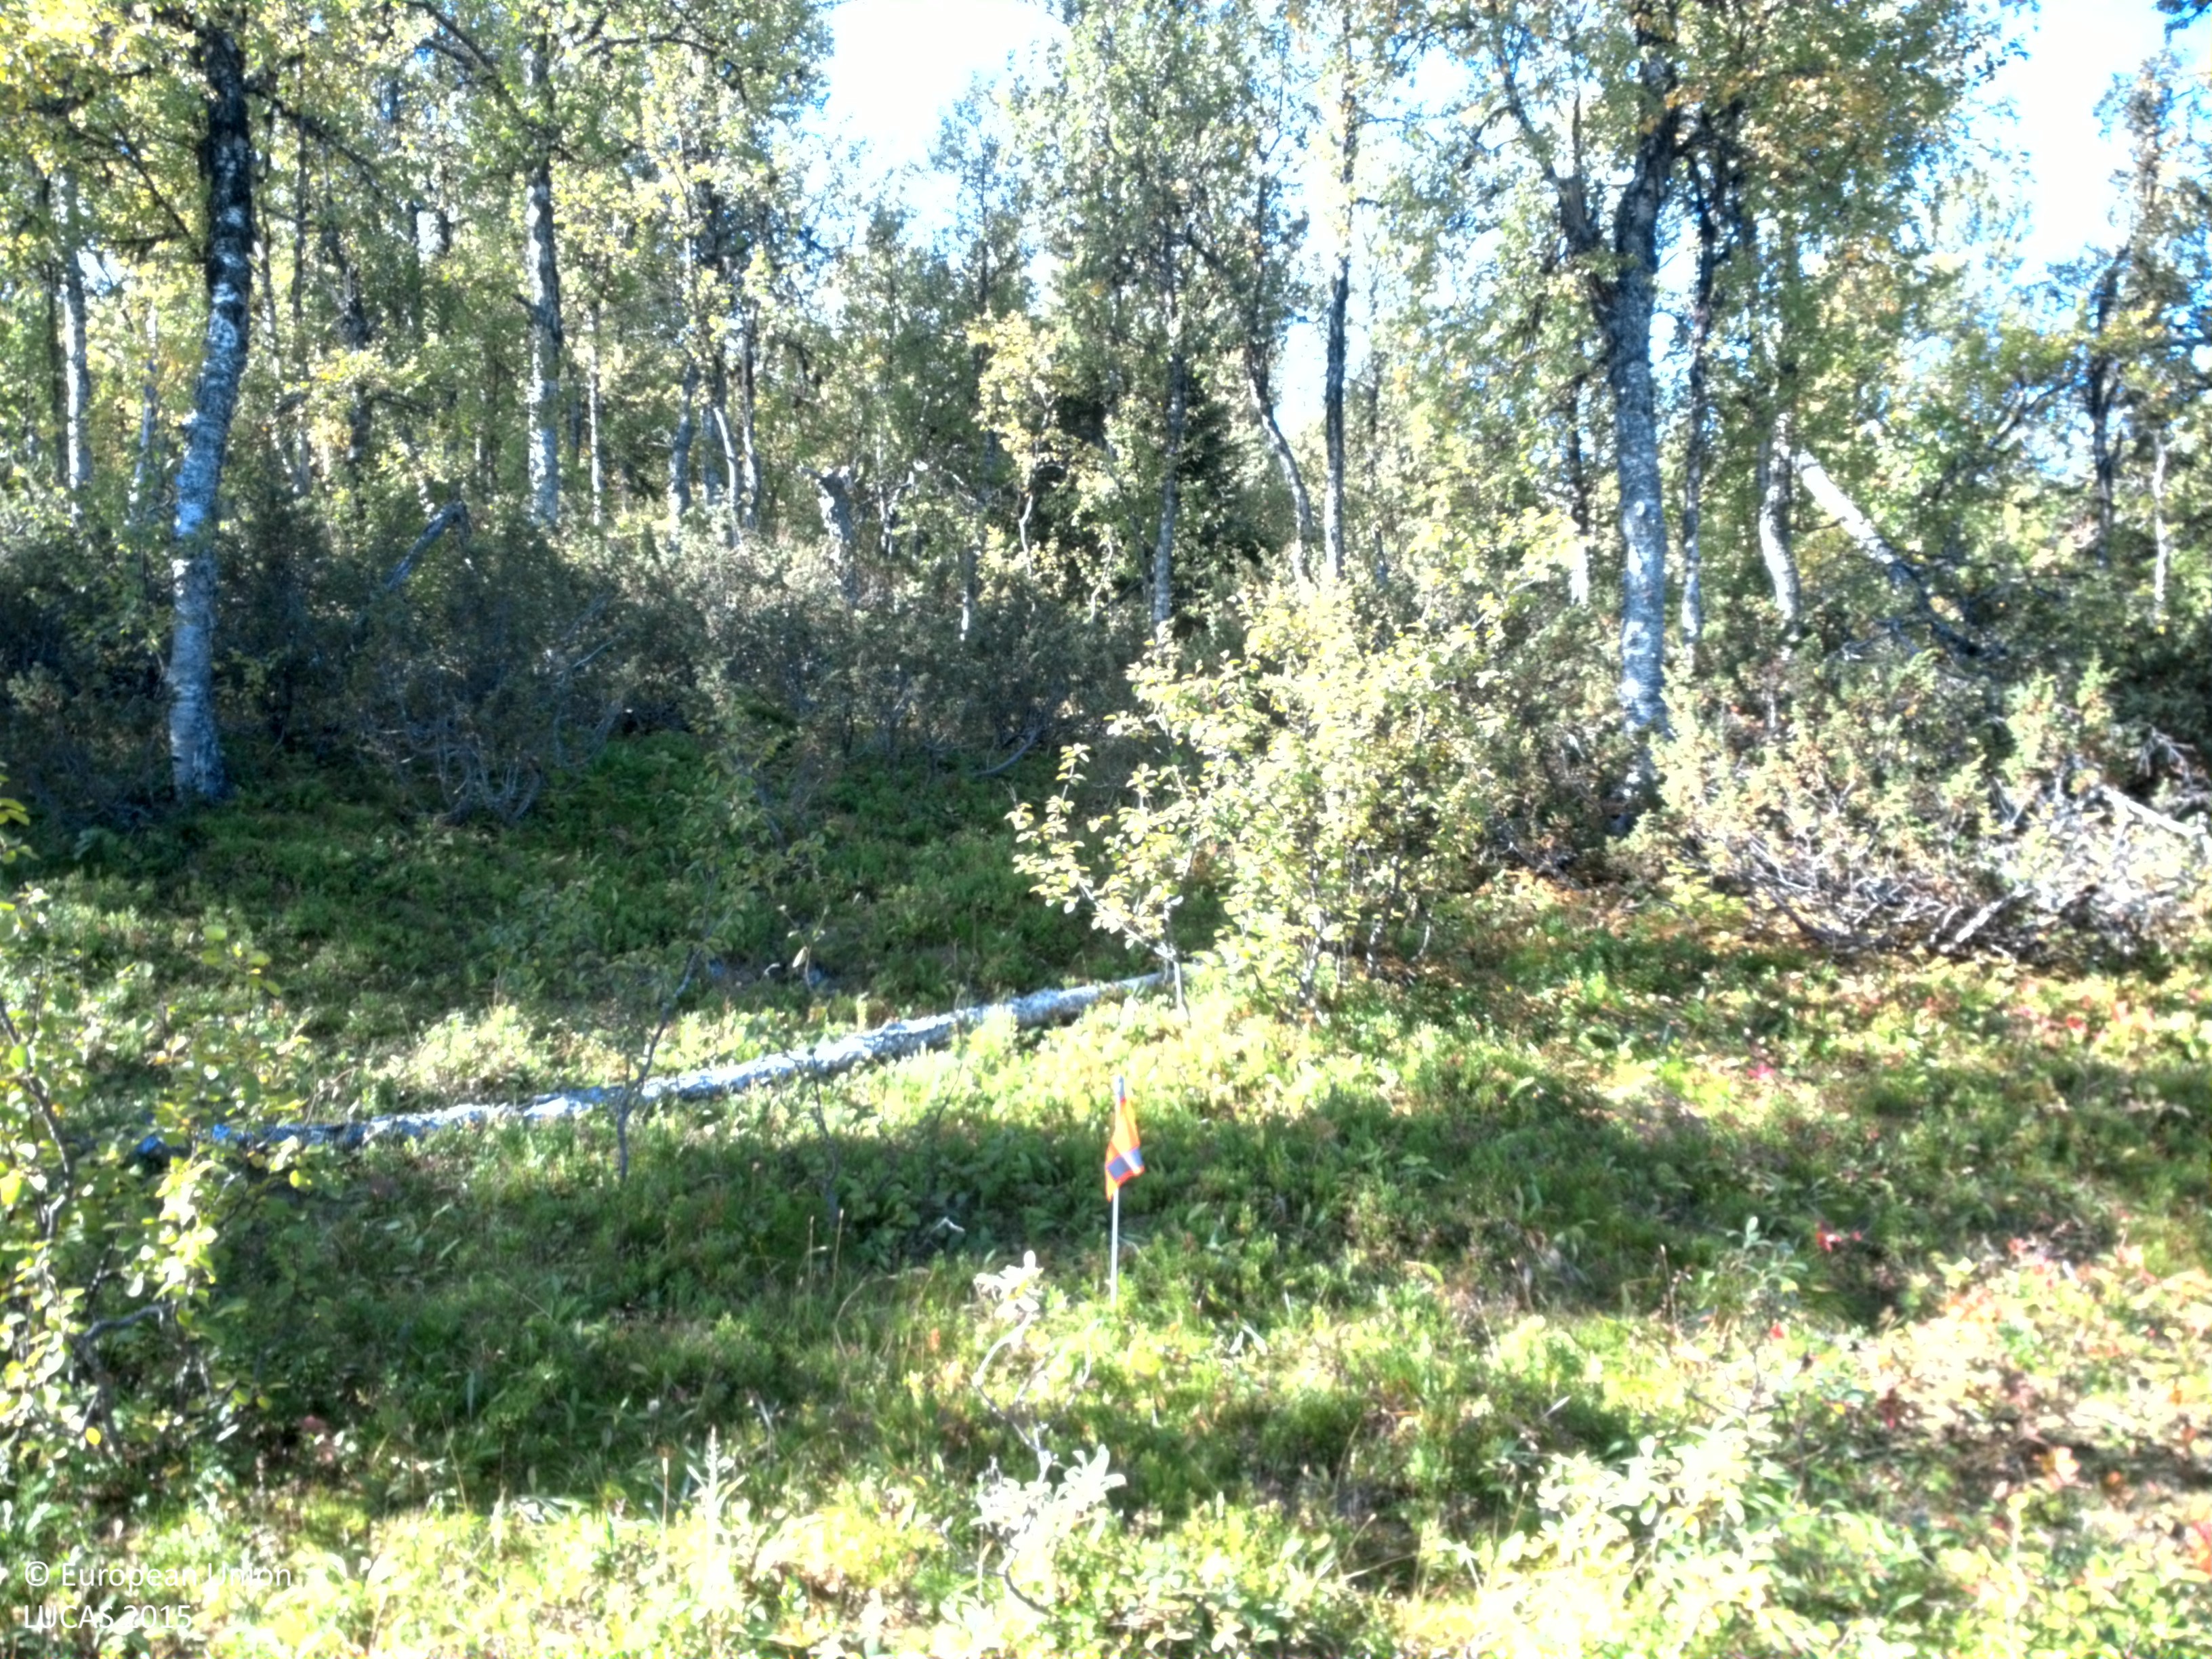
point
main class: Woodland
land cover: Broadleaved woodland
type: non-riverine alder, birch or aspen forest
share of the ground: 10 - 25 %
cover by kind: shrubs 50 %, herbaceous plants 30 %, broadleaved forest trees 15 %, lichens and mosses 5 %
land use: Amenities, museums, leisure
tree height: > 5 m
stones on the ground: < 10 %
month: September
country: SE
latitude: 65.8461
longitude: 16.4202
